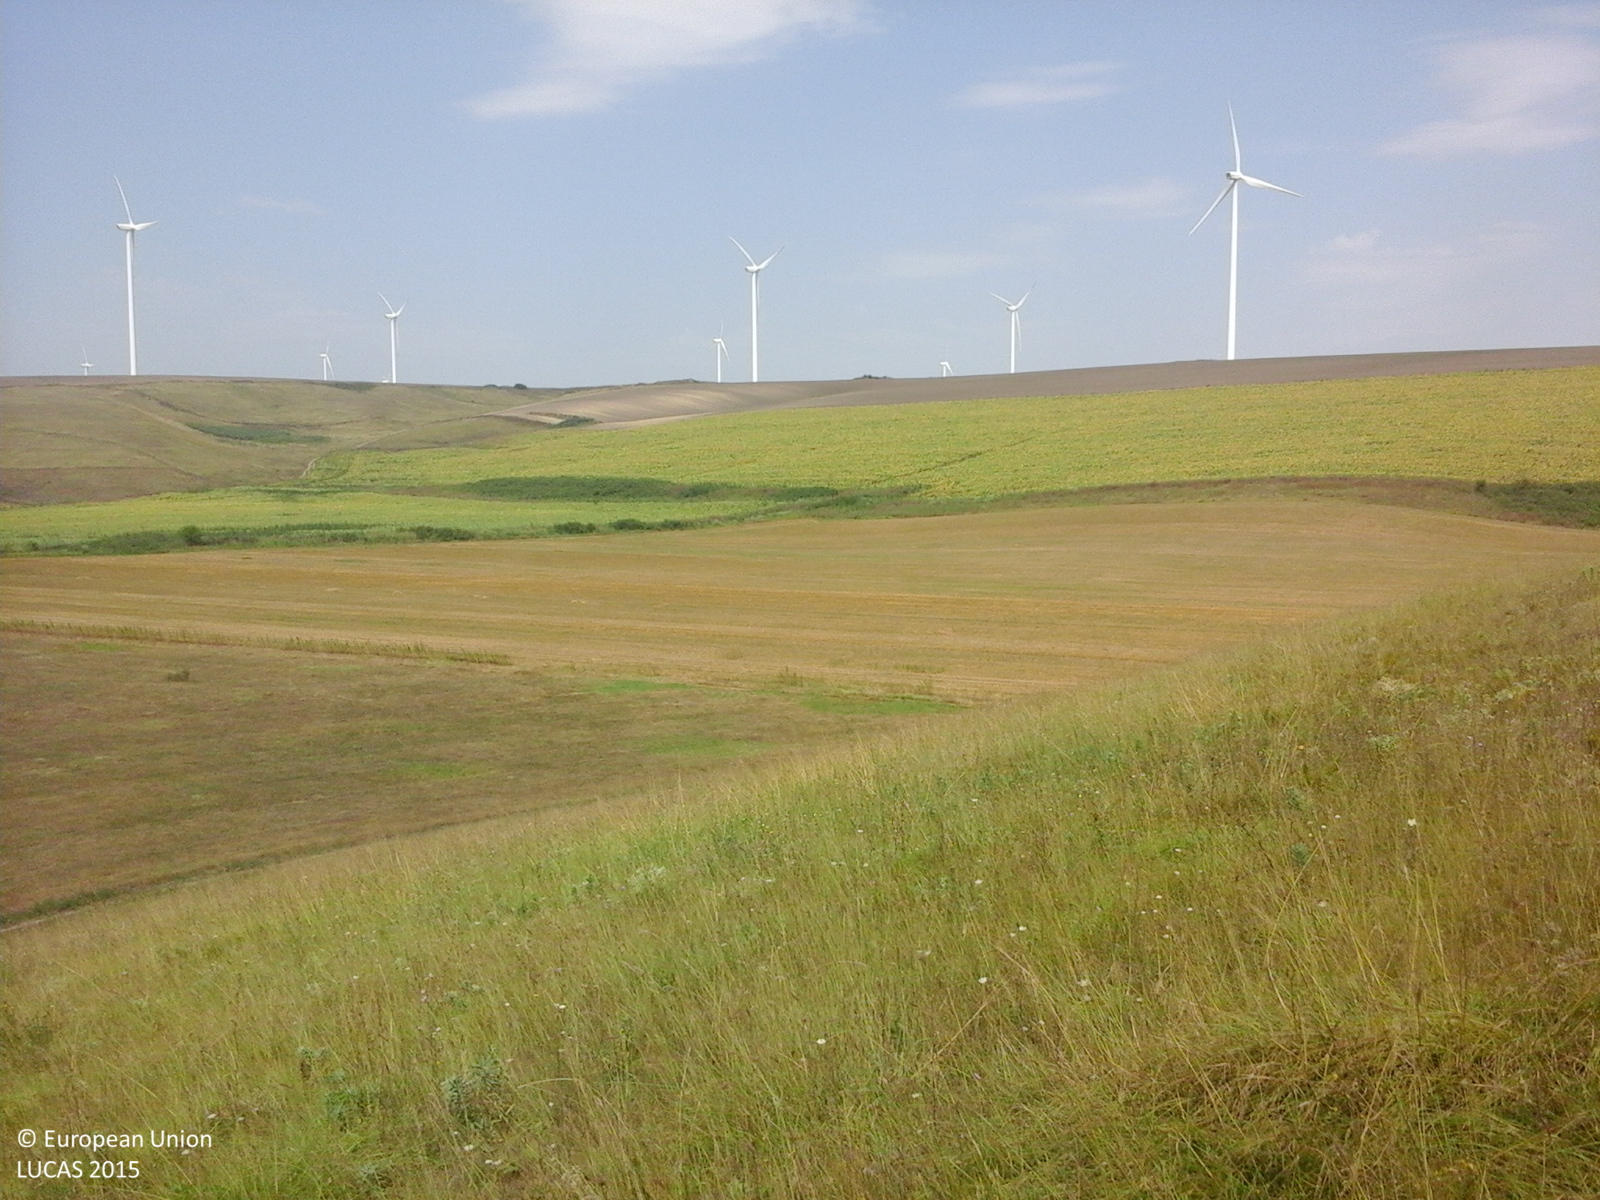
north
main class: Grassland
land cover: Grassland without tree/shrub cover
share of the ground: > 75 %
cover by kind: herbaceous plants 100 %
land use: Agriculture (excluding fallow land and kitchen gardens)
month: August
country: RO
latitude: 44.1888
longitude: 28.0587
